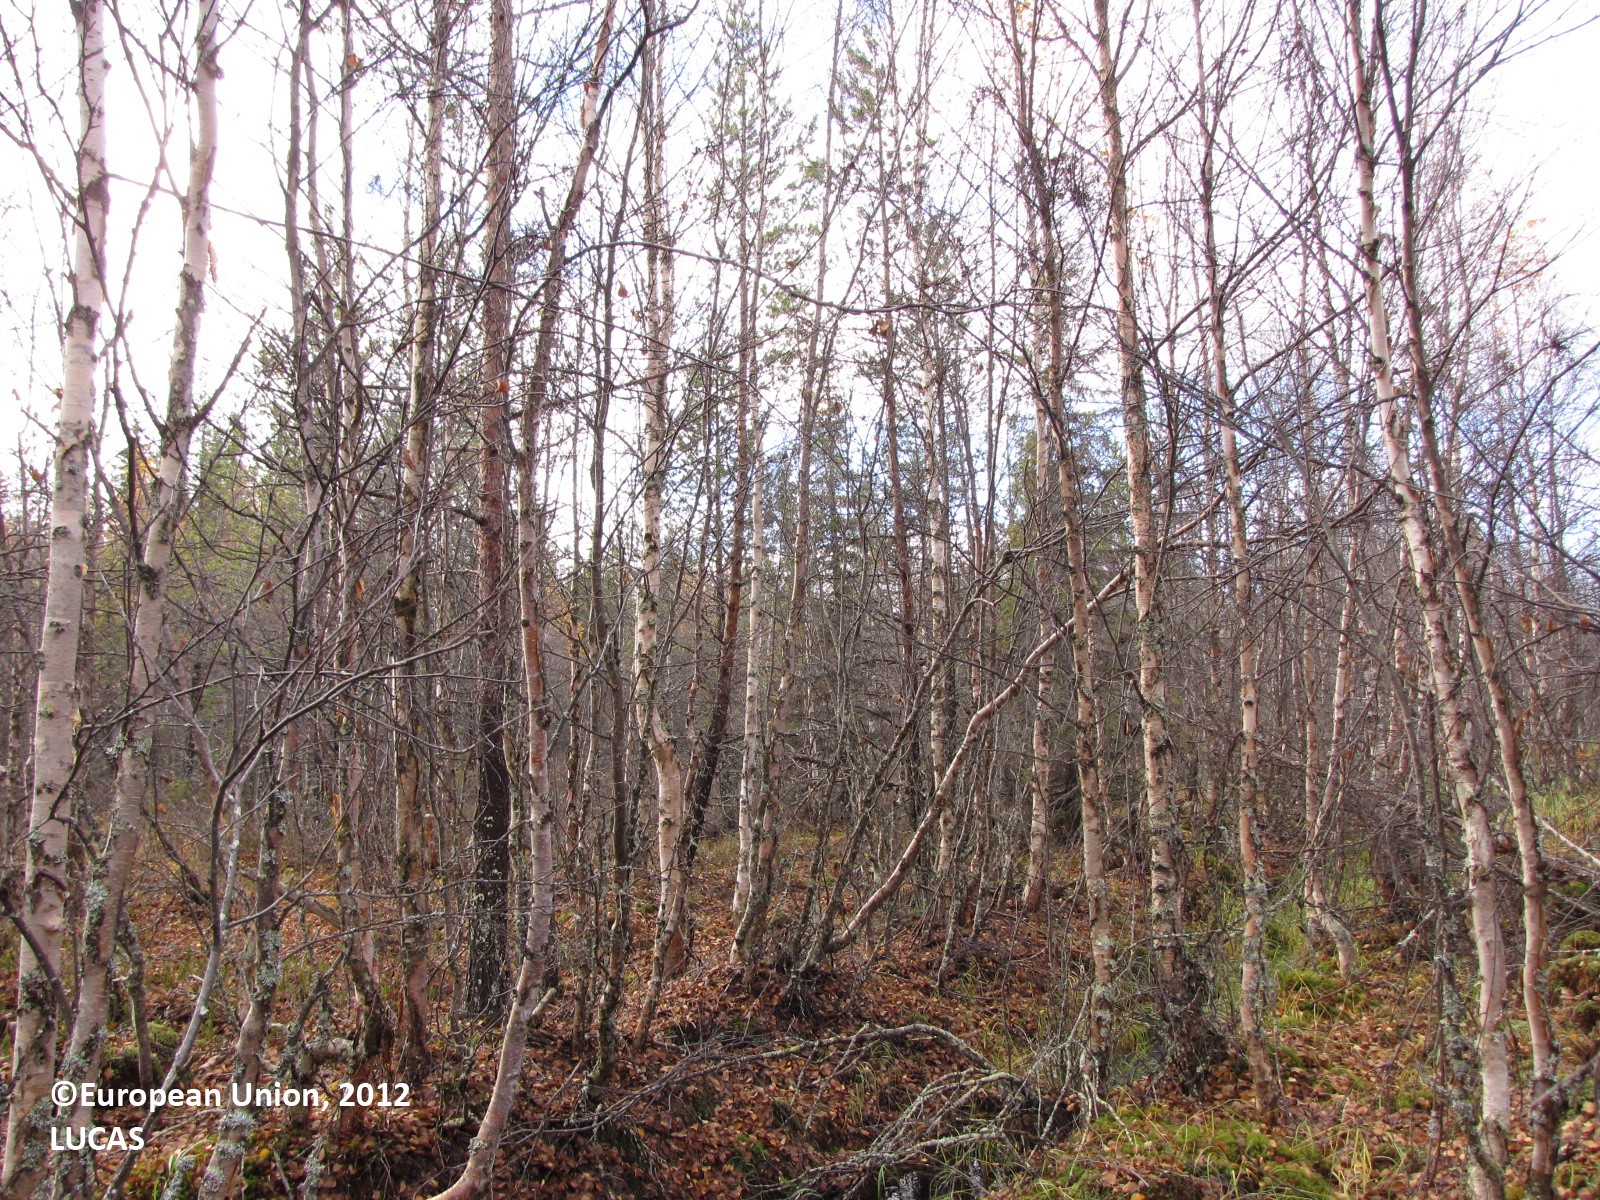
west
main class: Woodland
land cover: Broadleaved woodland
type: boreal forest
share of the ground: > 75 %
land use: Forestry
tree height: > 5 m
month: September
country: FI
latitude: 67.4781
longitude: 25.1319
